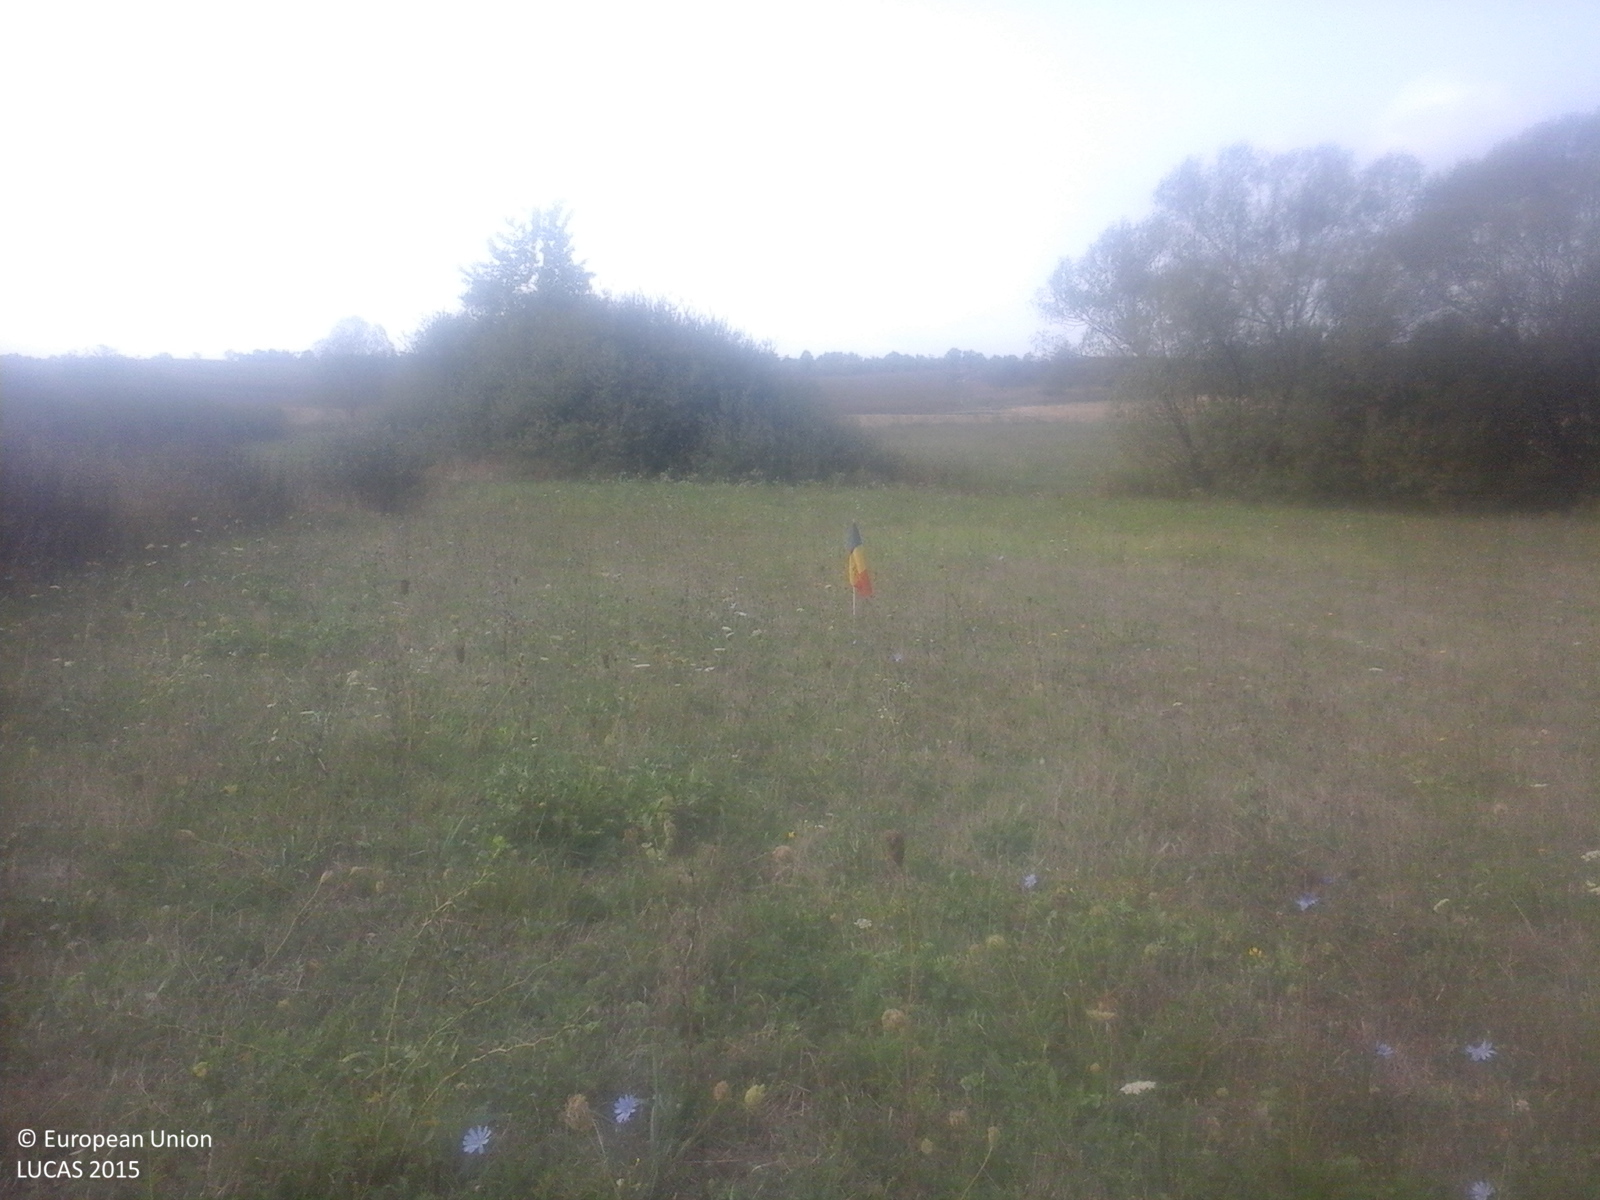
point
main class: Grassland
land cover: Grassland without tree/shrub cover
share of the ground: > 75 %
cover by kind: herbaceous plants 100 %
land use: Agriculture (excluding fallow land and kitchen gardens)
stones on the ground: < 10 %
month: September
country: RO
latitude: 45.4402
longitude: 21.9653
